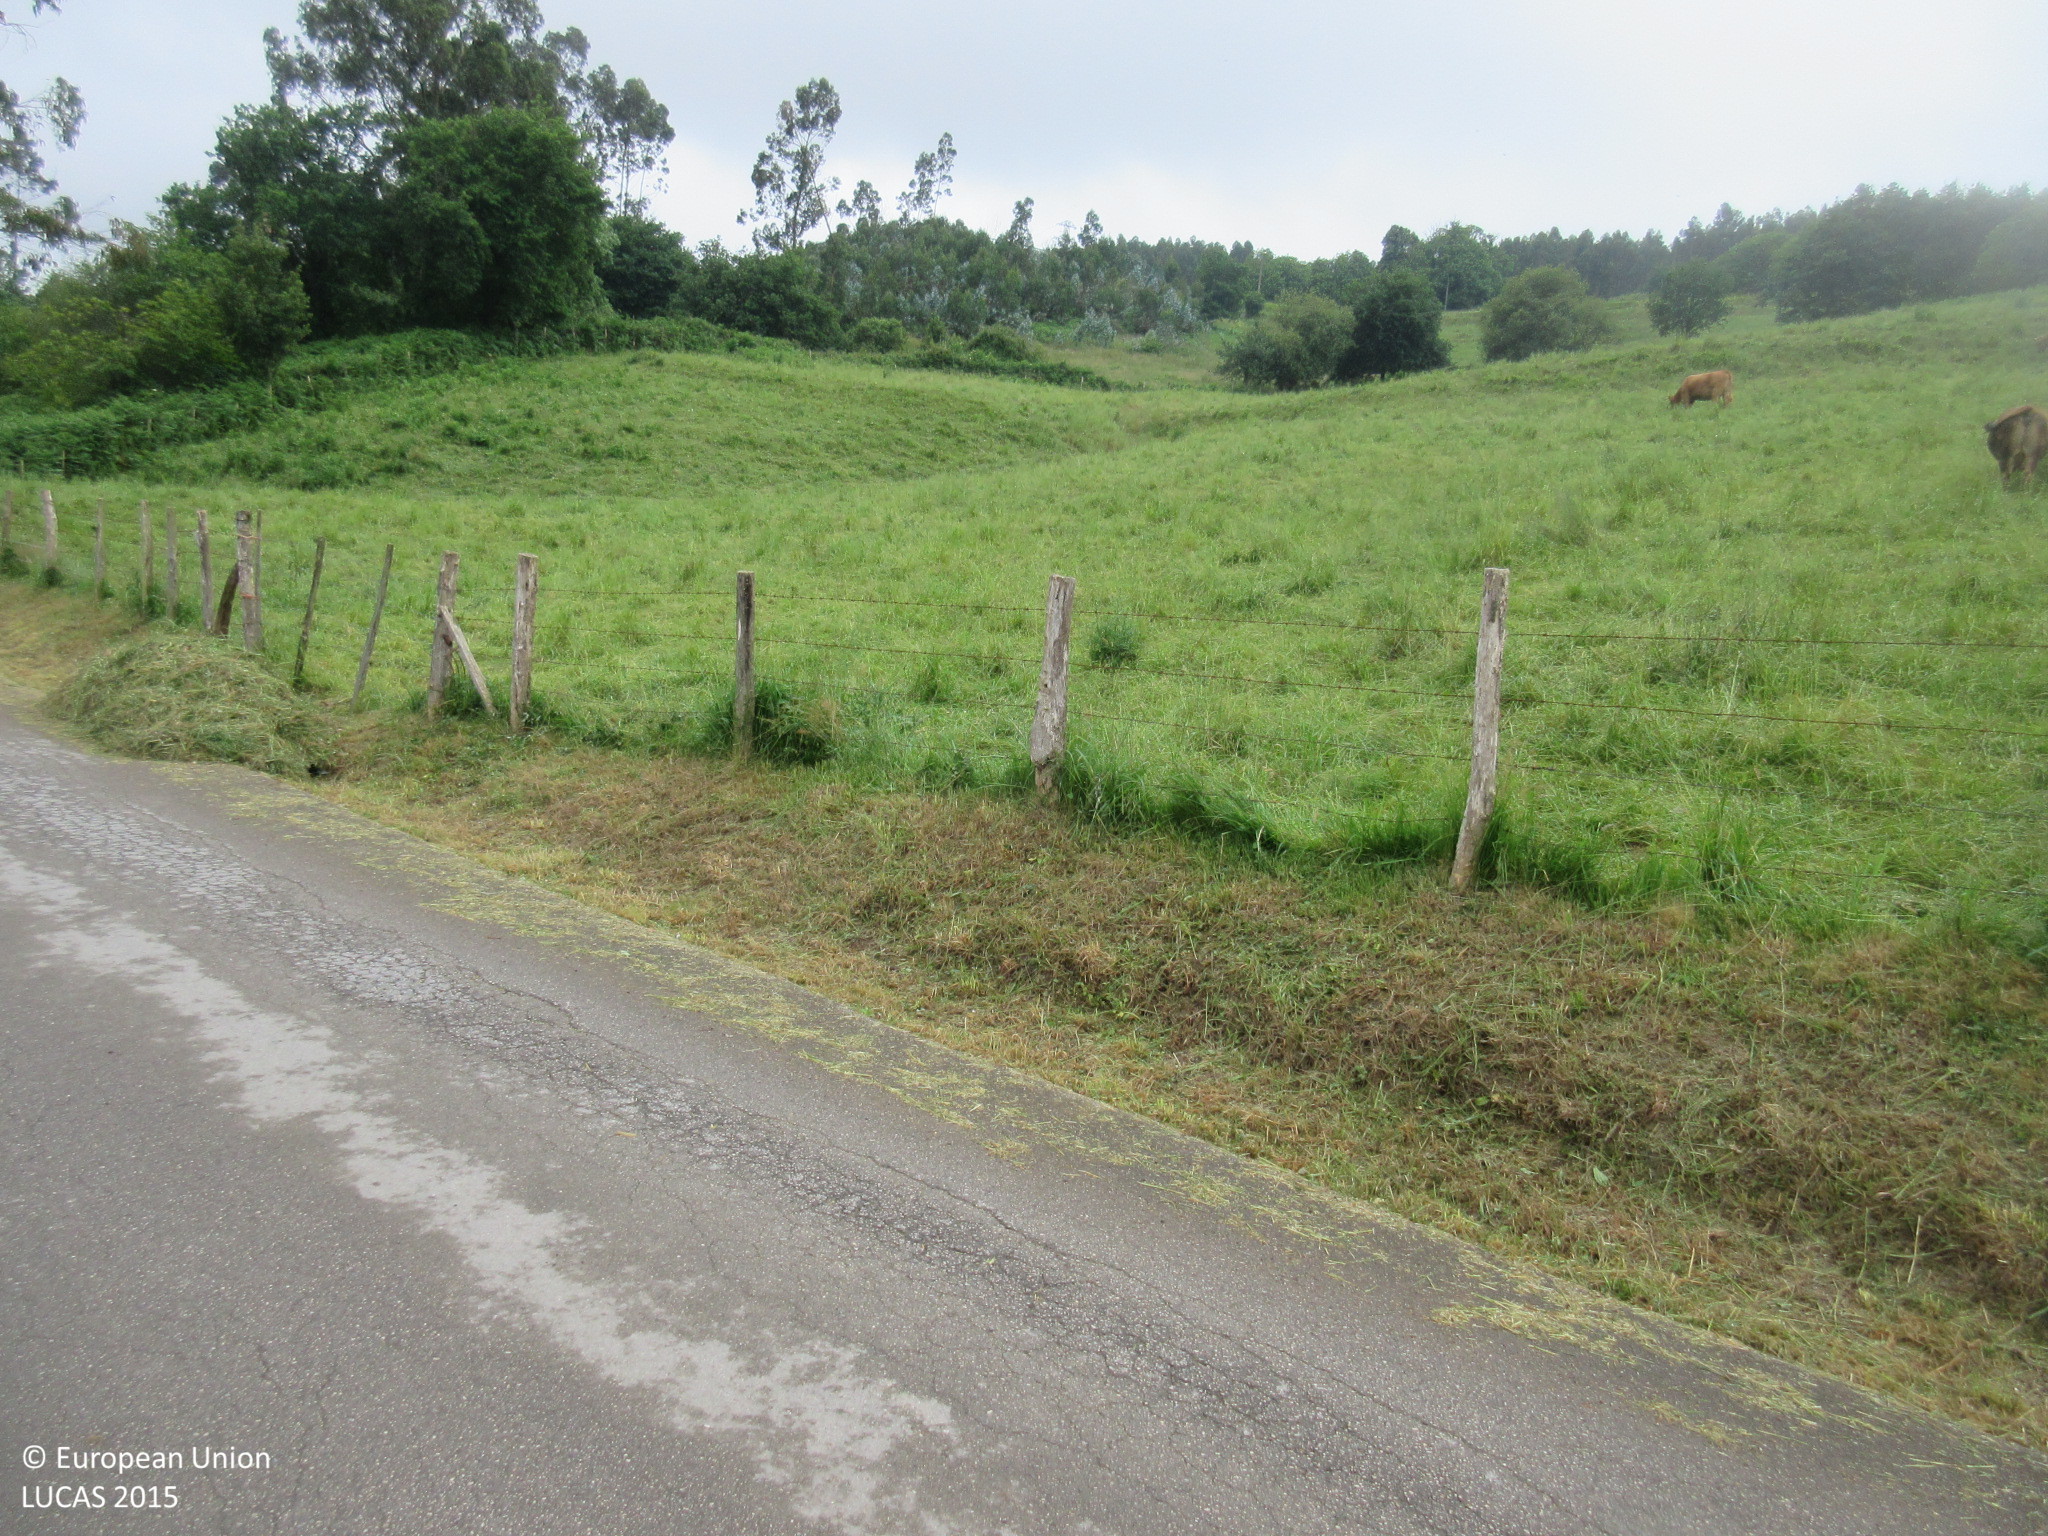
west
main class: Grassland
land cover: Grassland without tree/shrub cover
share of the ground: > 75 %
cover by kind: herbaceous plants 100 %
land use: Agriculture (excluding fallow land and kitchen gardens)
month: June
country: ES
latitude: 43.4325
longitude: -3.5976
